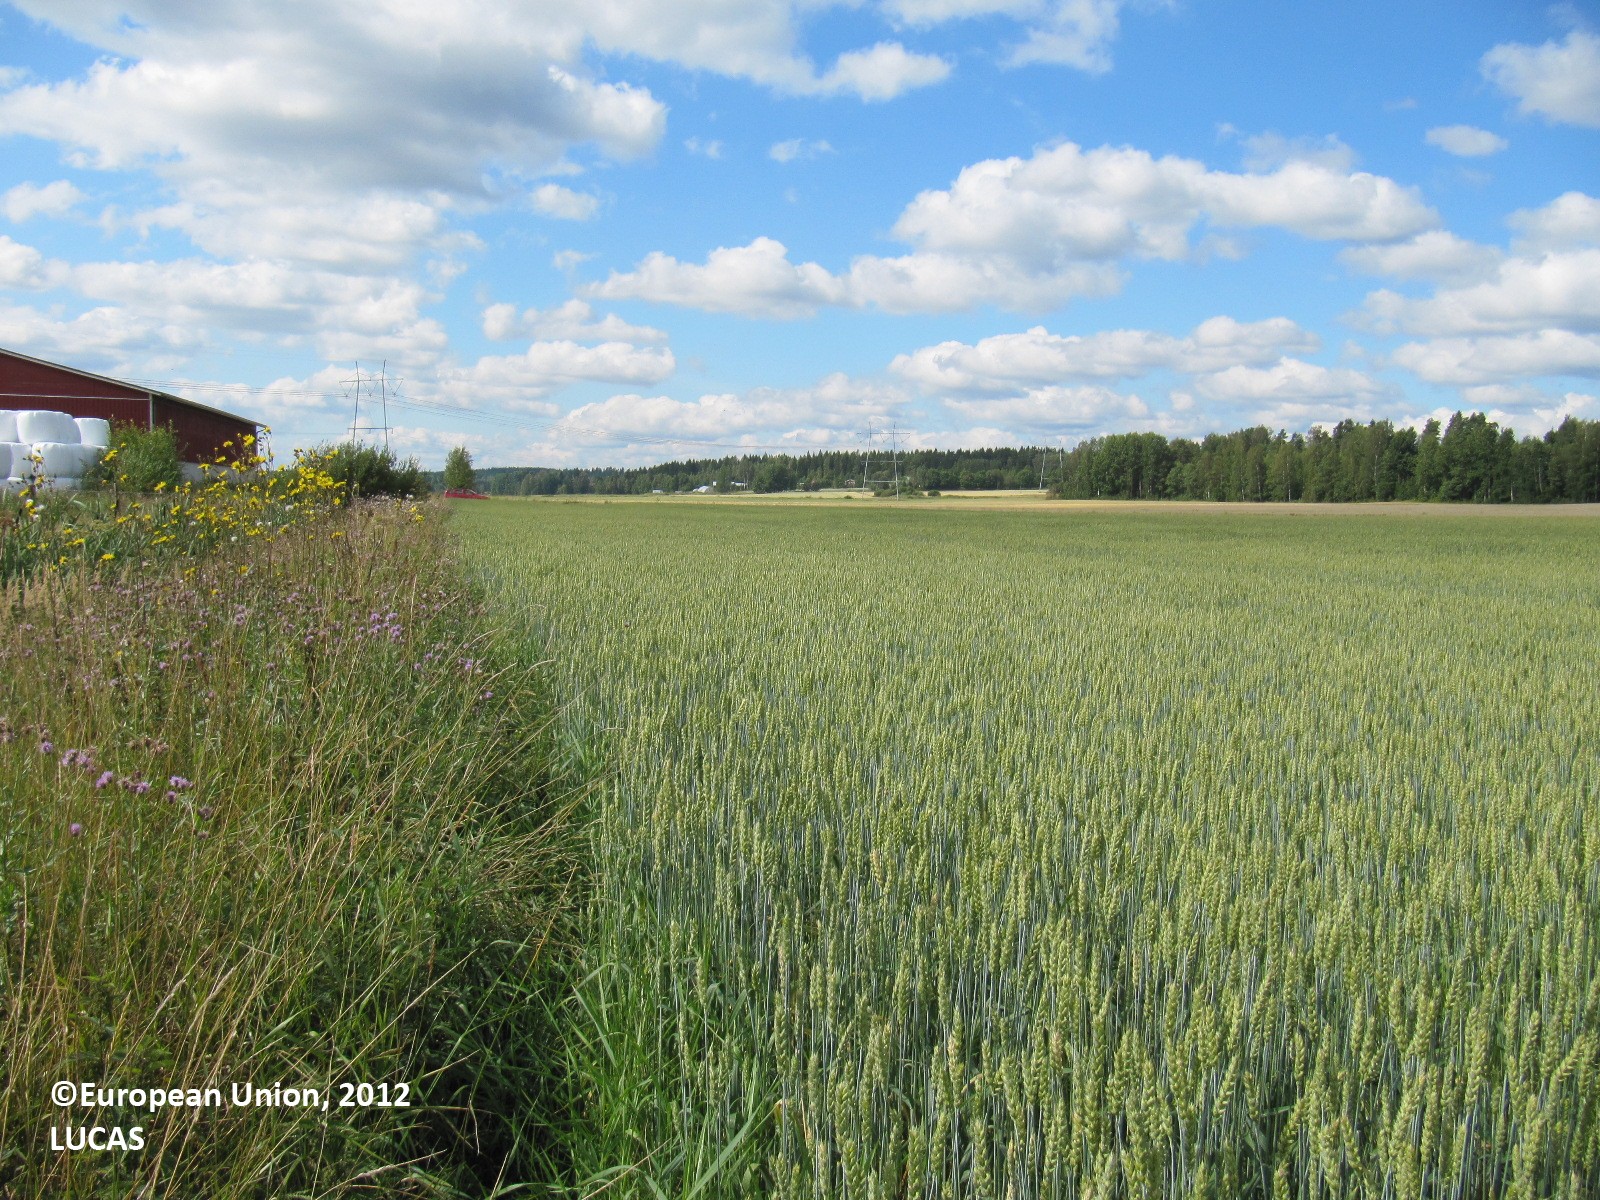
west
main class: Cropland
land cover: Common wheat
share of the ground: > 75 %
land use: Agriculture (excluding fallow land and kitchen gardens)
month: August
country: FI
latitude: 60.4687
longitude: 24.5303
